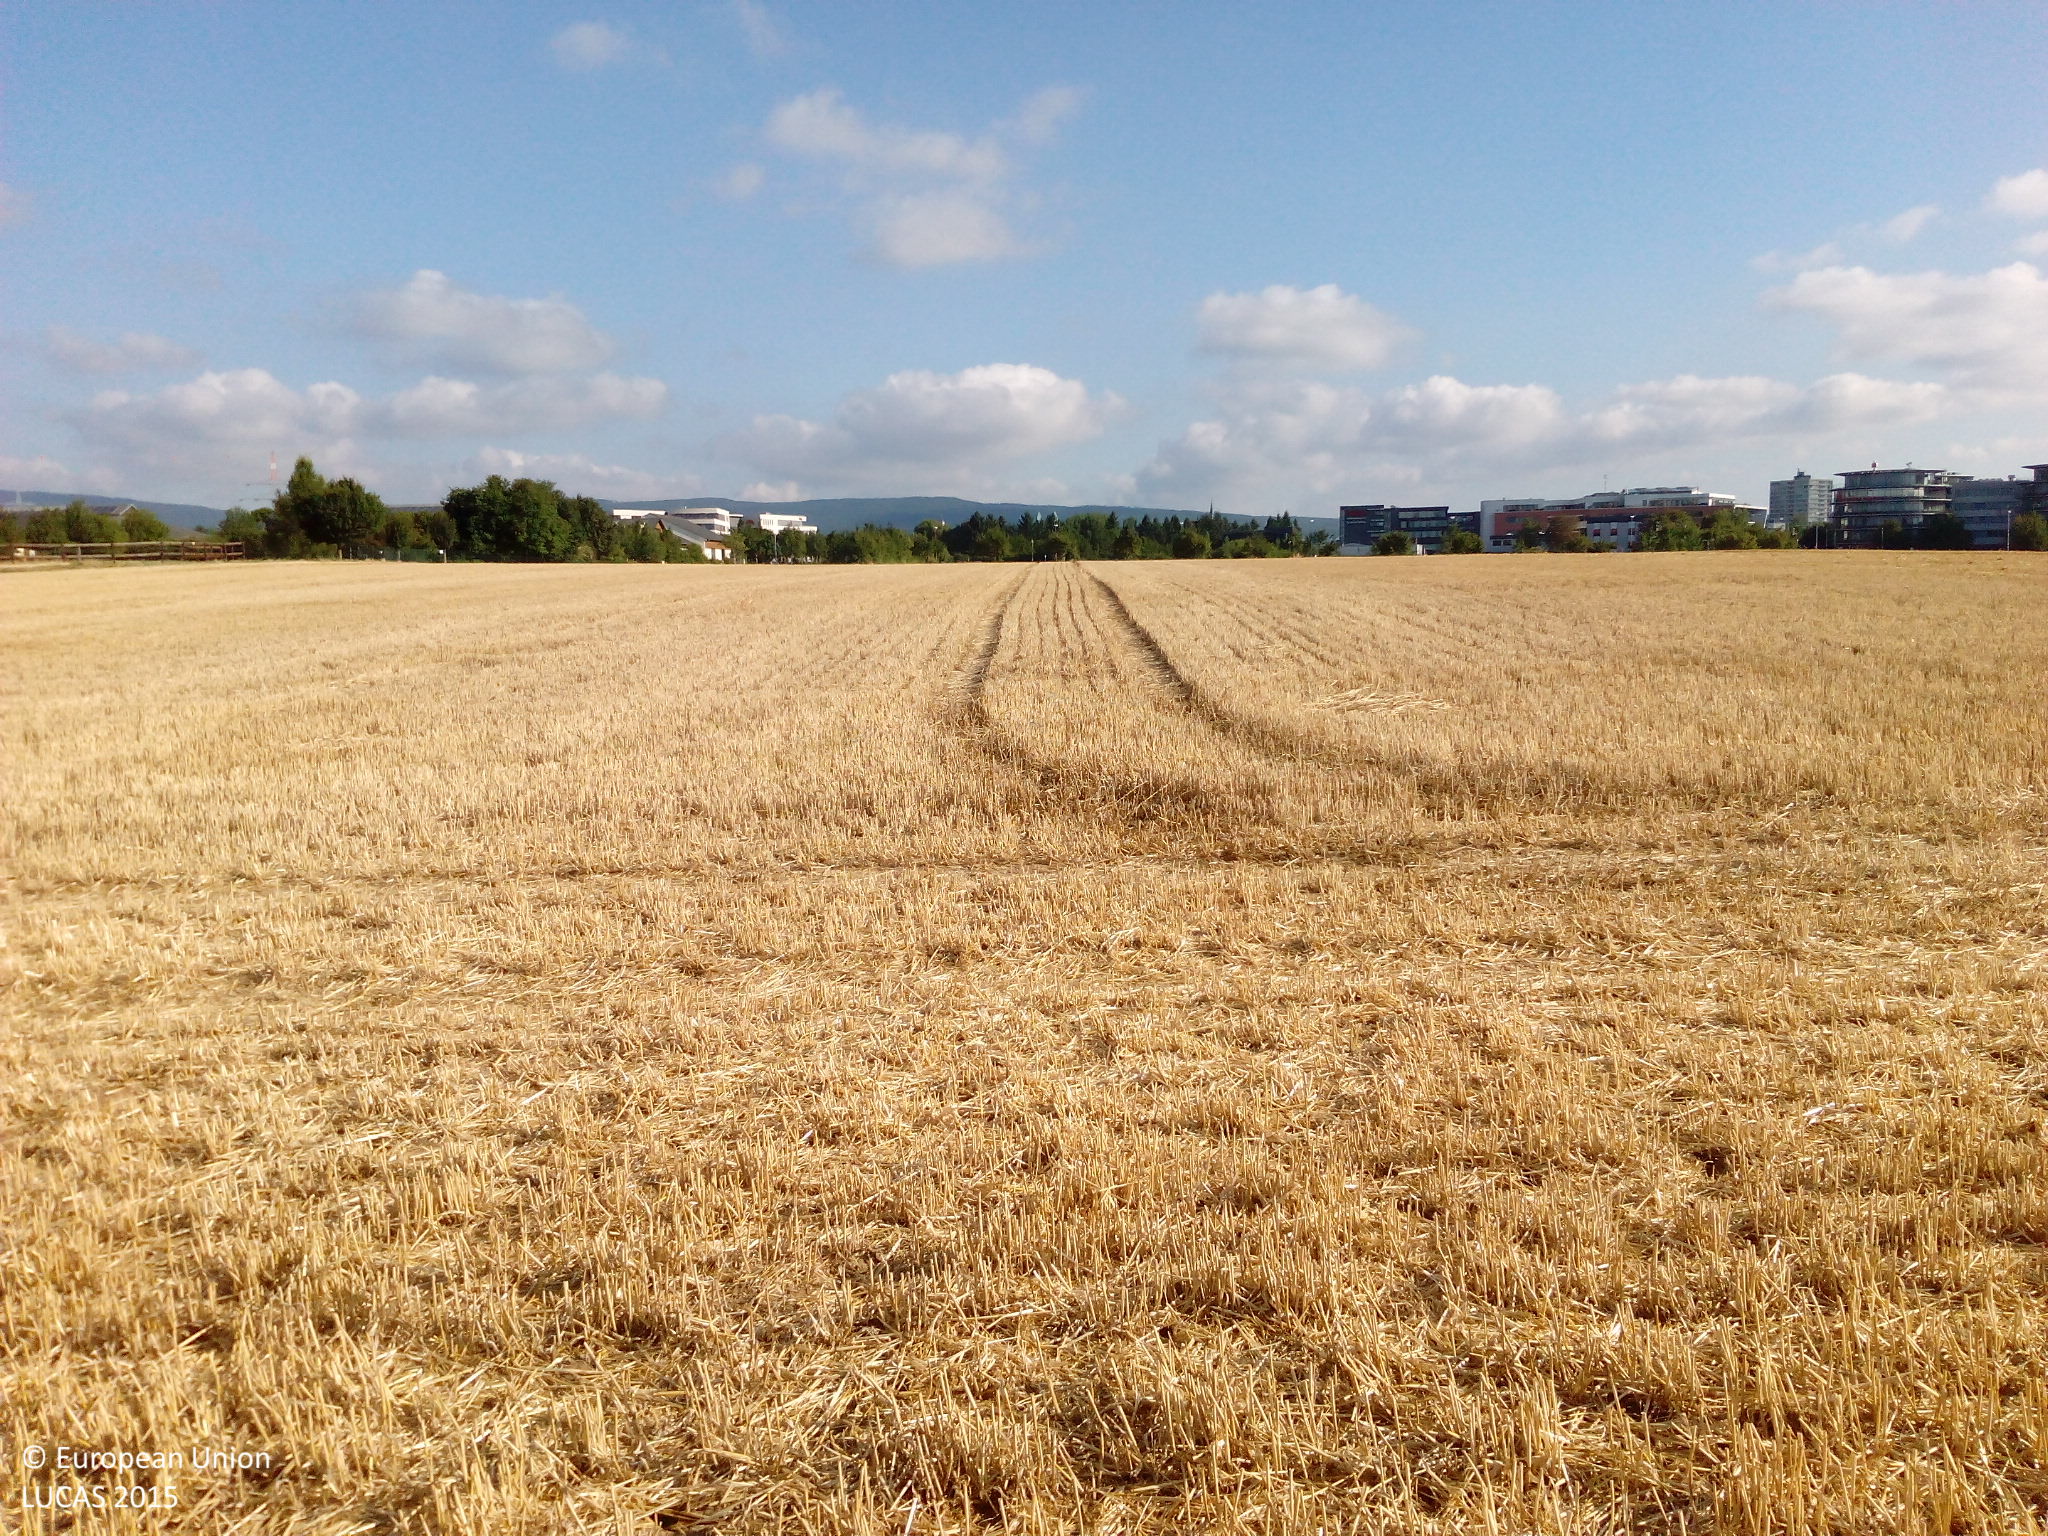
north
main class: Cropland
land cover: Common wheat
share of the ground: 50 - 75 %
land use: Agriculture (excluding fallow land and kitchen gardens)
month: July
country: DE
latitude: 50.2118
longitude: 8.6131
